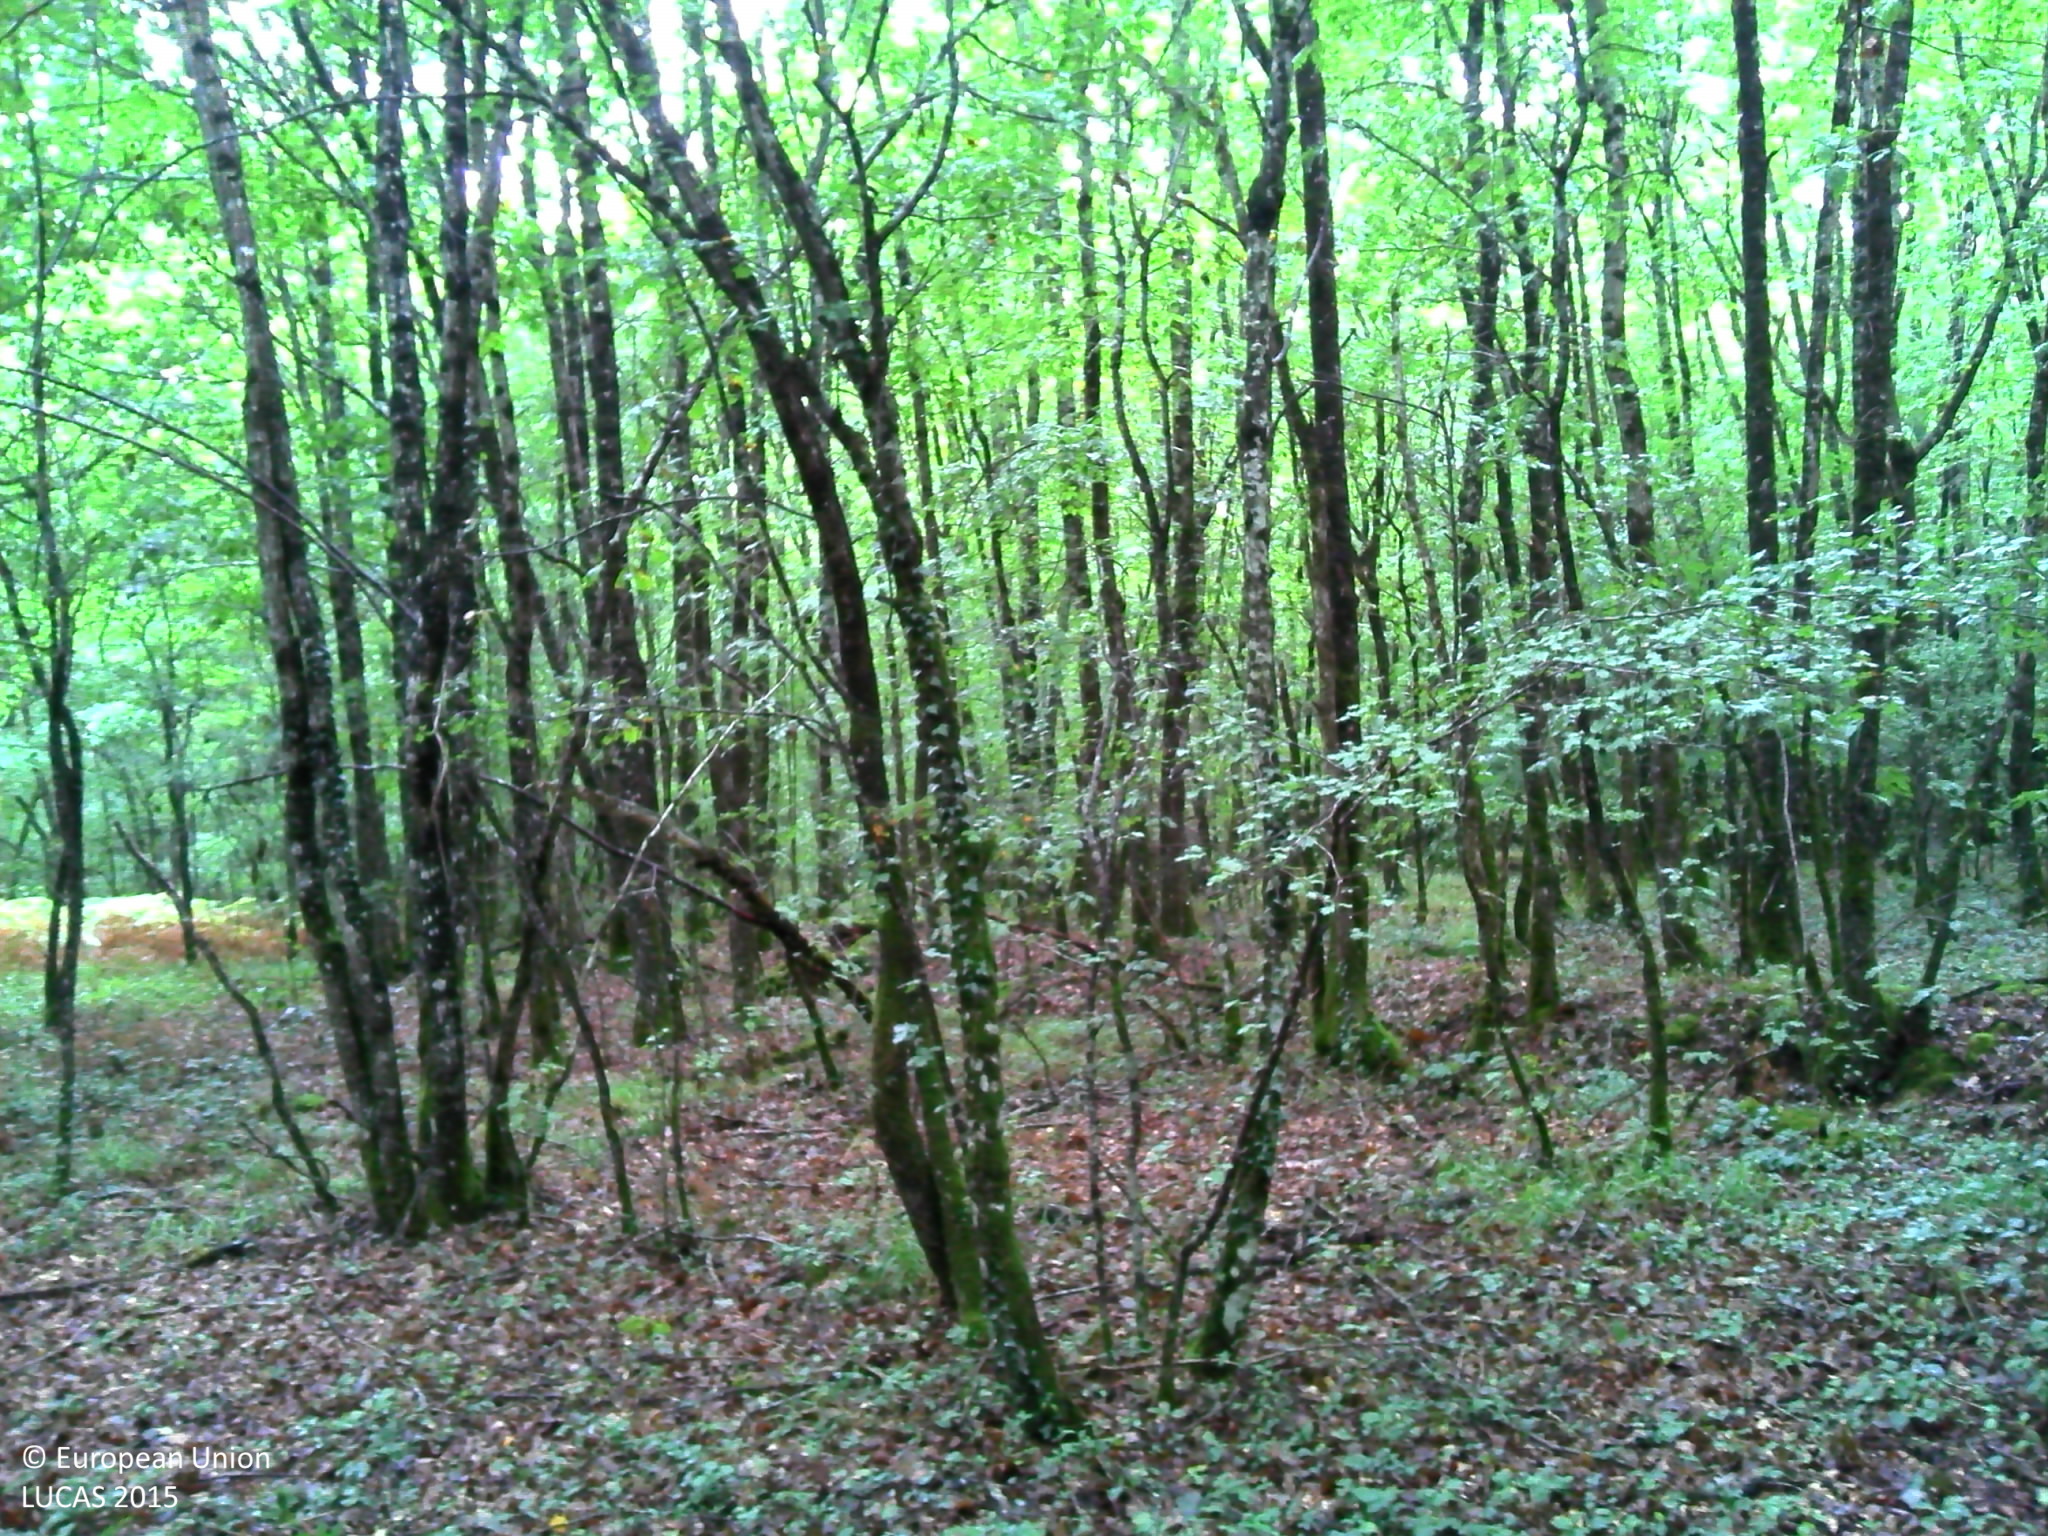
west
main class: Woodland
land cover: Broadleaved woodland
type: mesophytic deciduous forest
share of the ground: > 75 %
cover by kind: broadleaved forest trees 85 %, herbaceous plants 10 %, unconsolidated bare surface 5 %
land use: Forestry
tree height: > 5 m
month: September
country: FR
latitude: 46.5839
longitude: 1.1783
